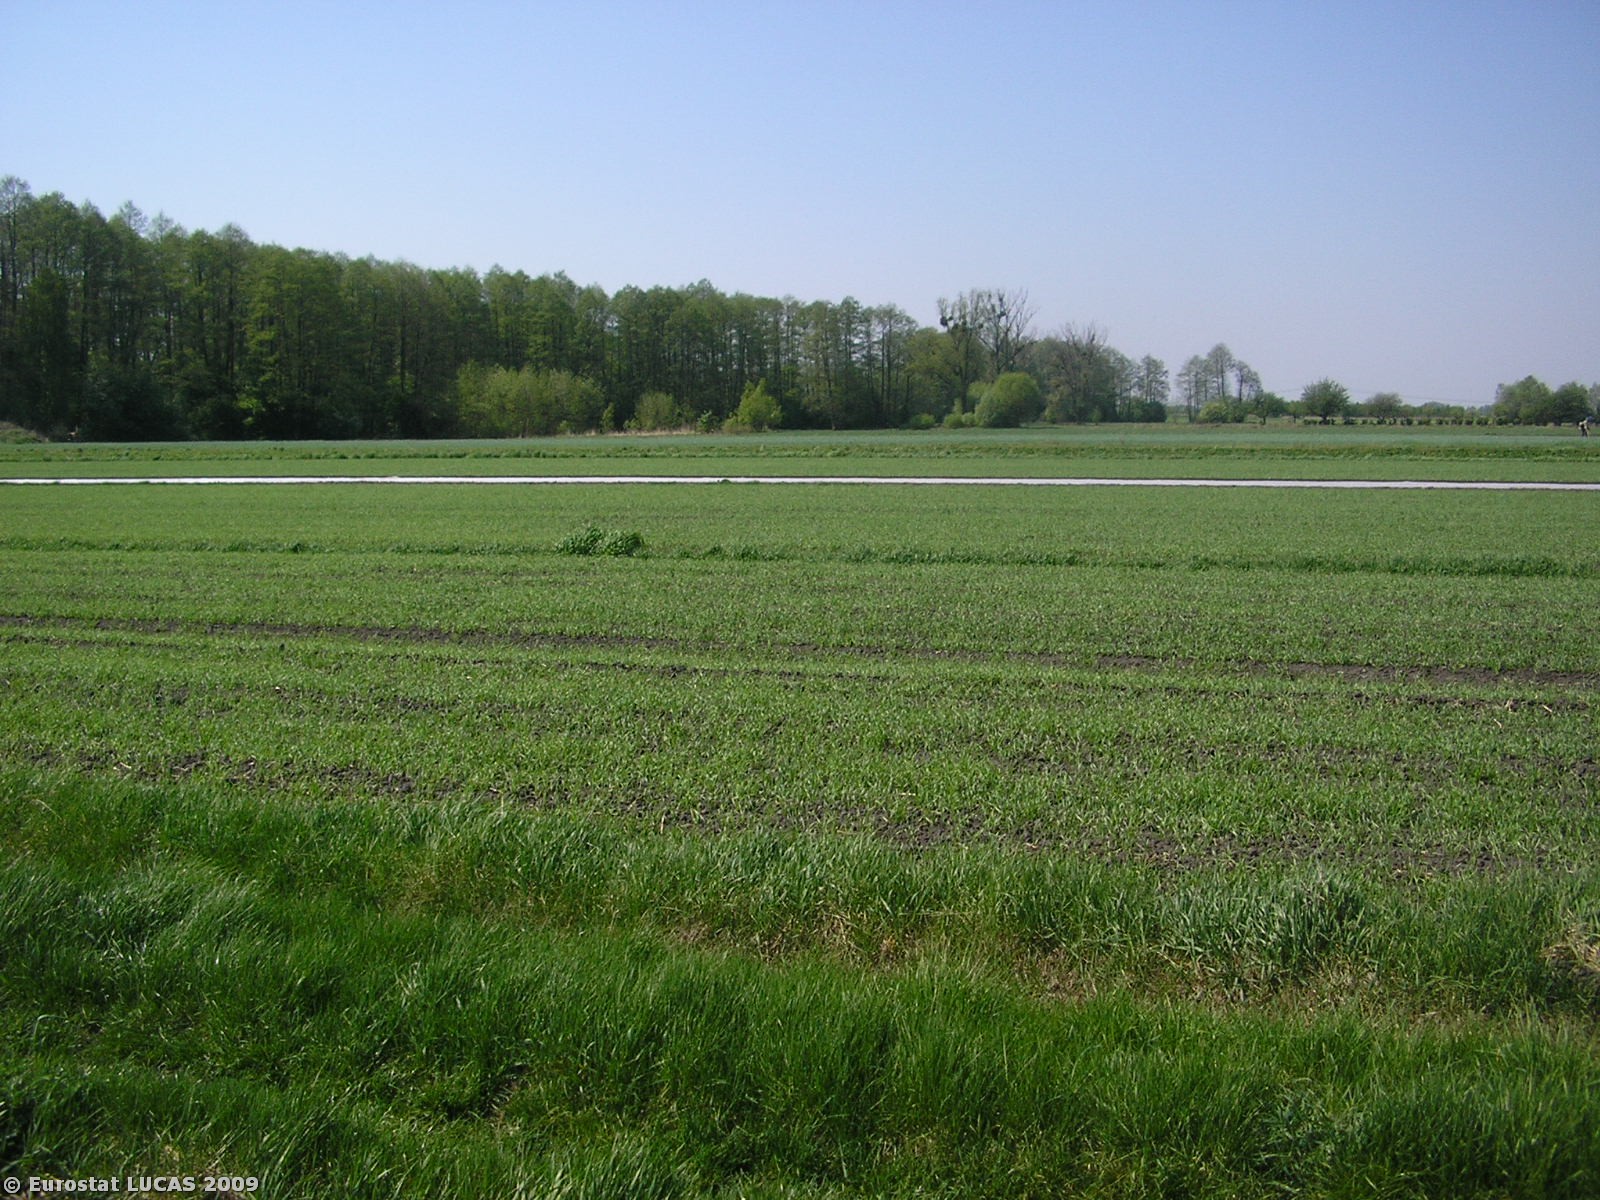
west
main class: Cropland
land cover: Common wheat
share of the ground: < 10 %
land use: Agriculture (excluding fallow land and kitchen gardens)
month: April
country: PL
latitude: 52.3047
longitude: 20.1389
